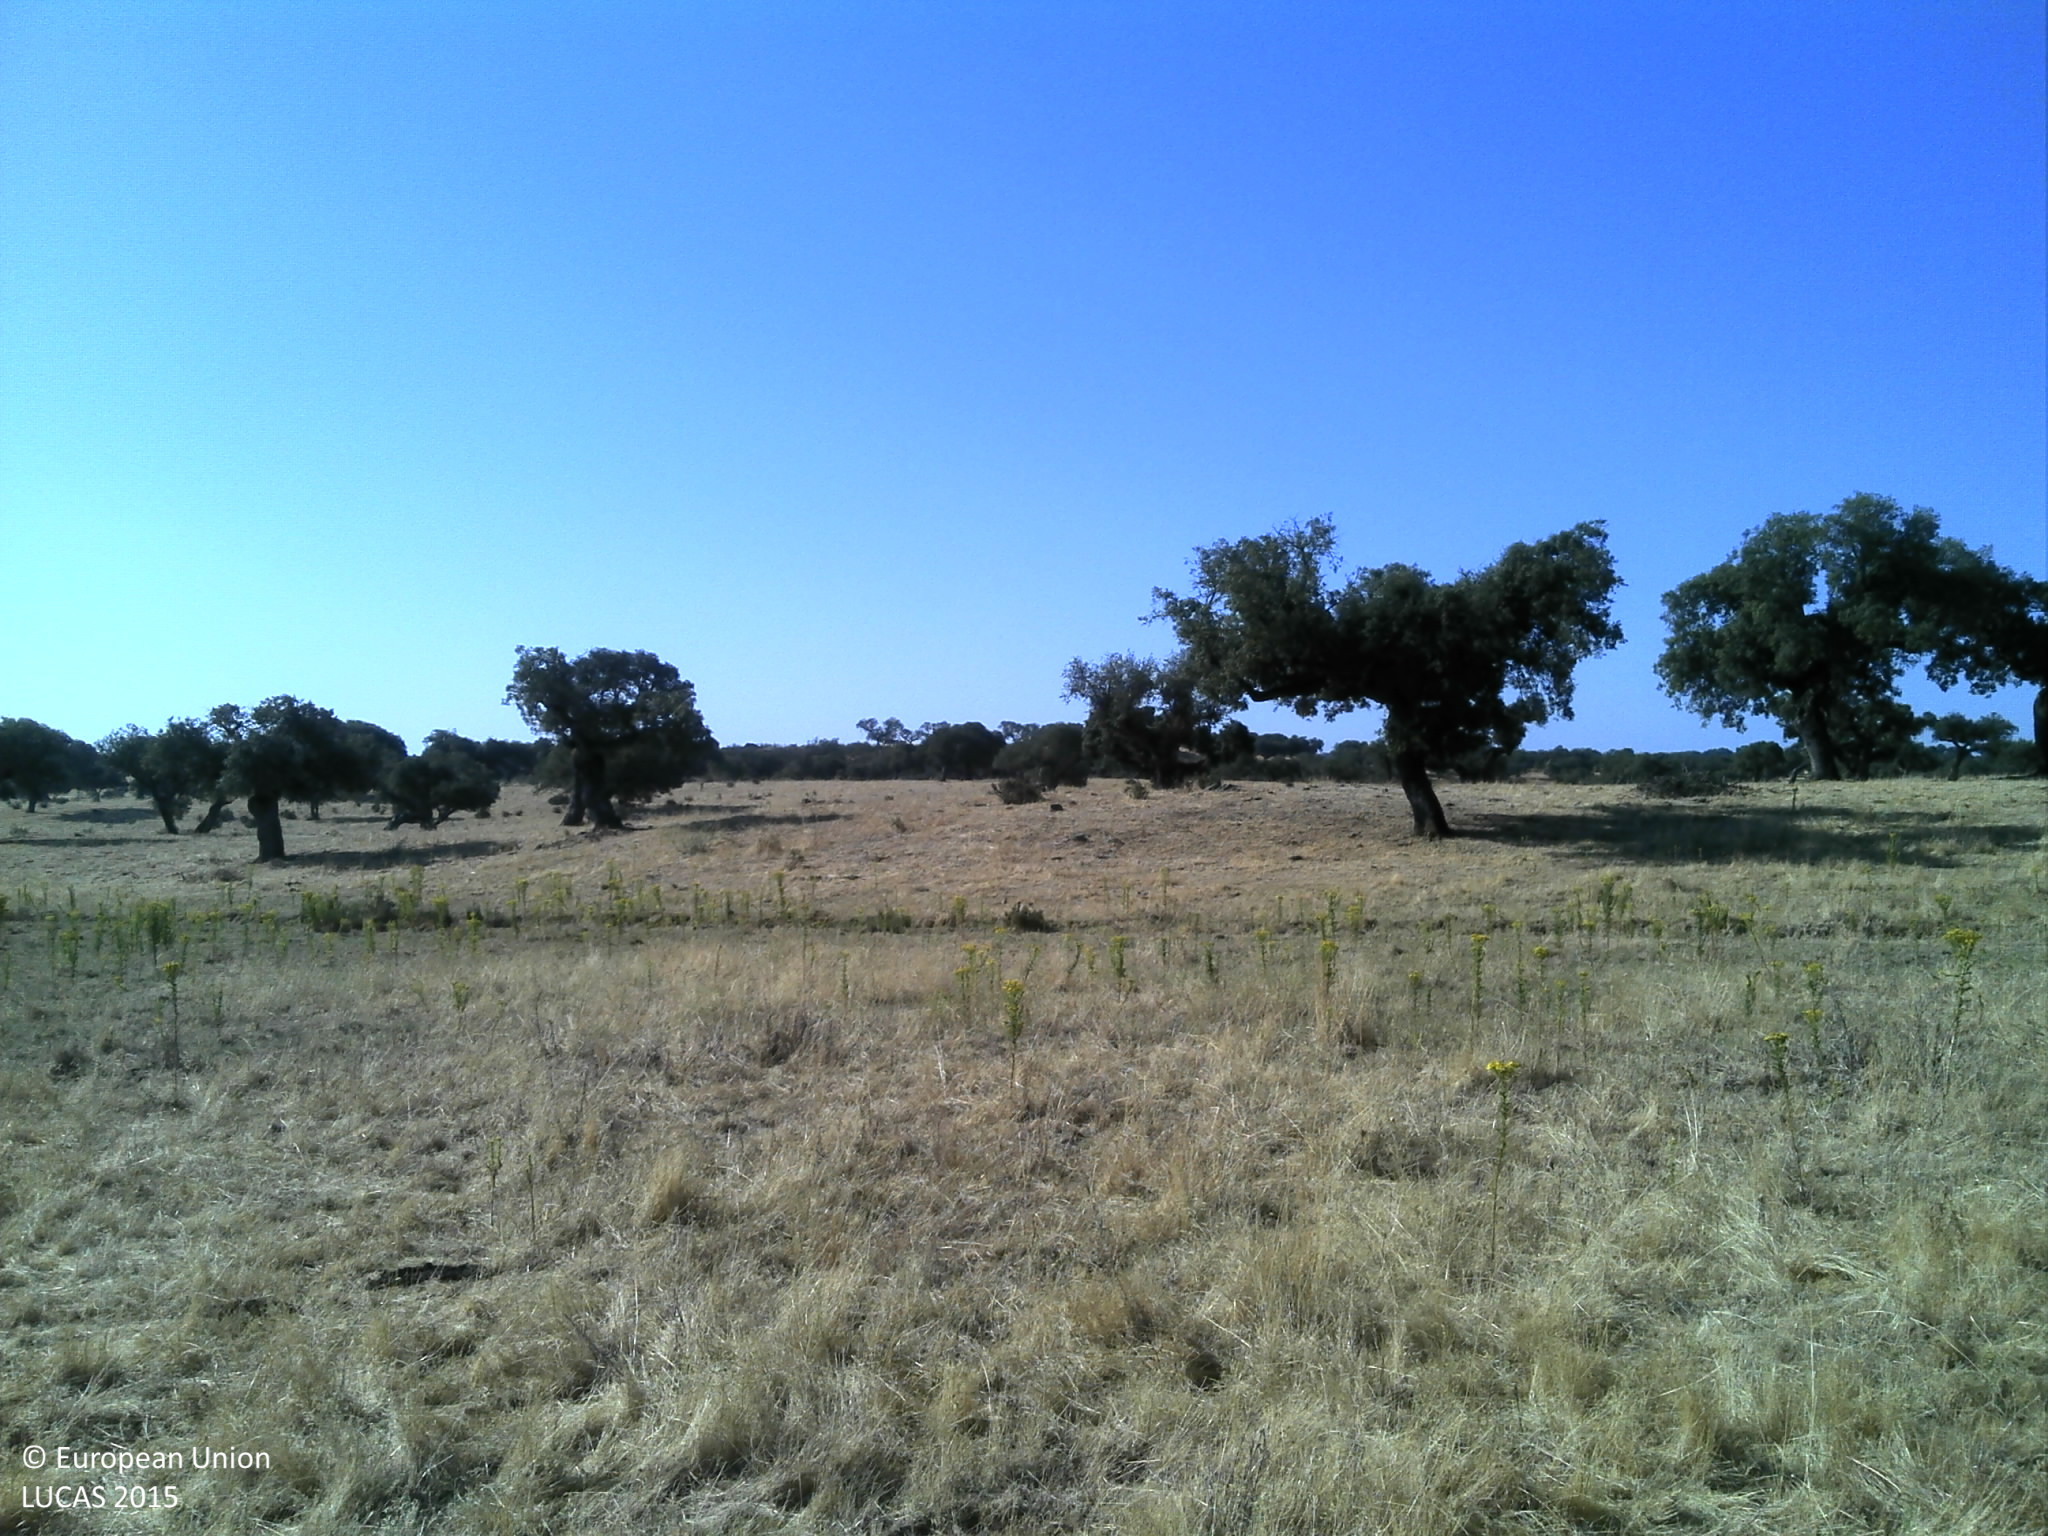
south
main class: Grassland
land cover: Grassland without tree/shrub cover
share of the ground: 50 - 75 %
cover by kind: herbaceous plants 60 %, unconsolidated bare surface 40 %
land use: Agriculture (excluding fallow land and kitchen gardens)
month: July
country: PT
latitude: 38.6619
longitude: -7.2998
